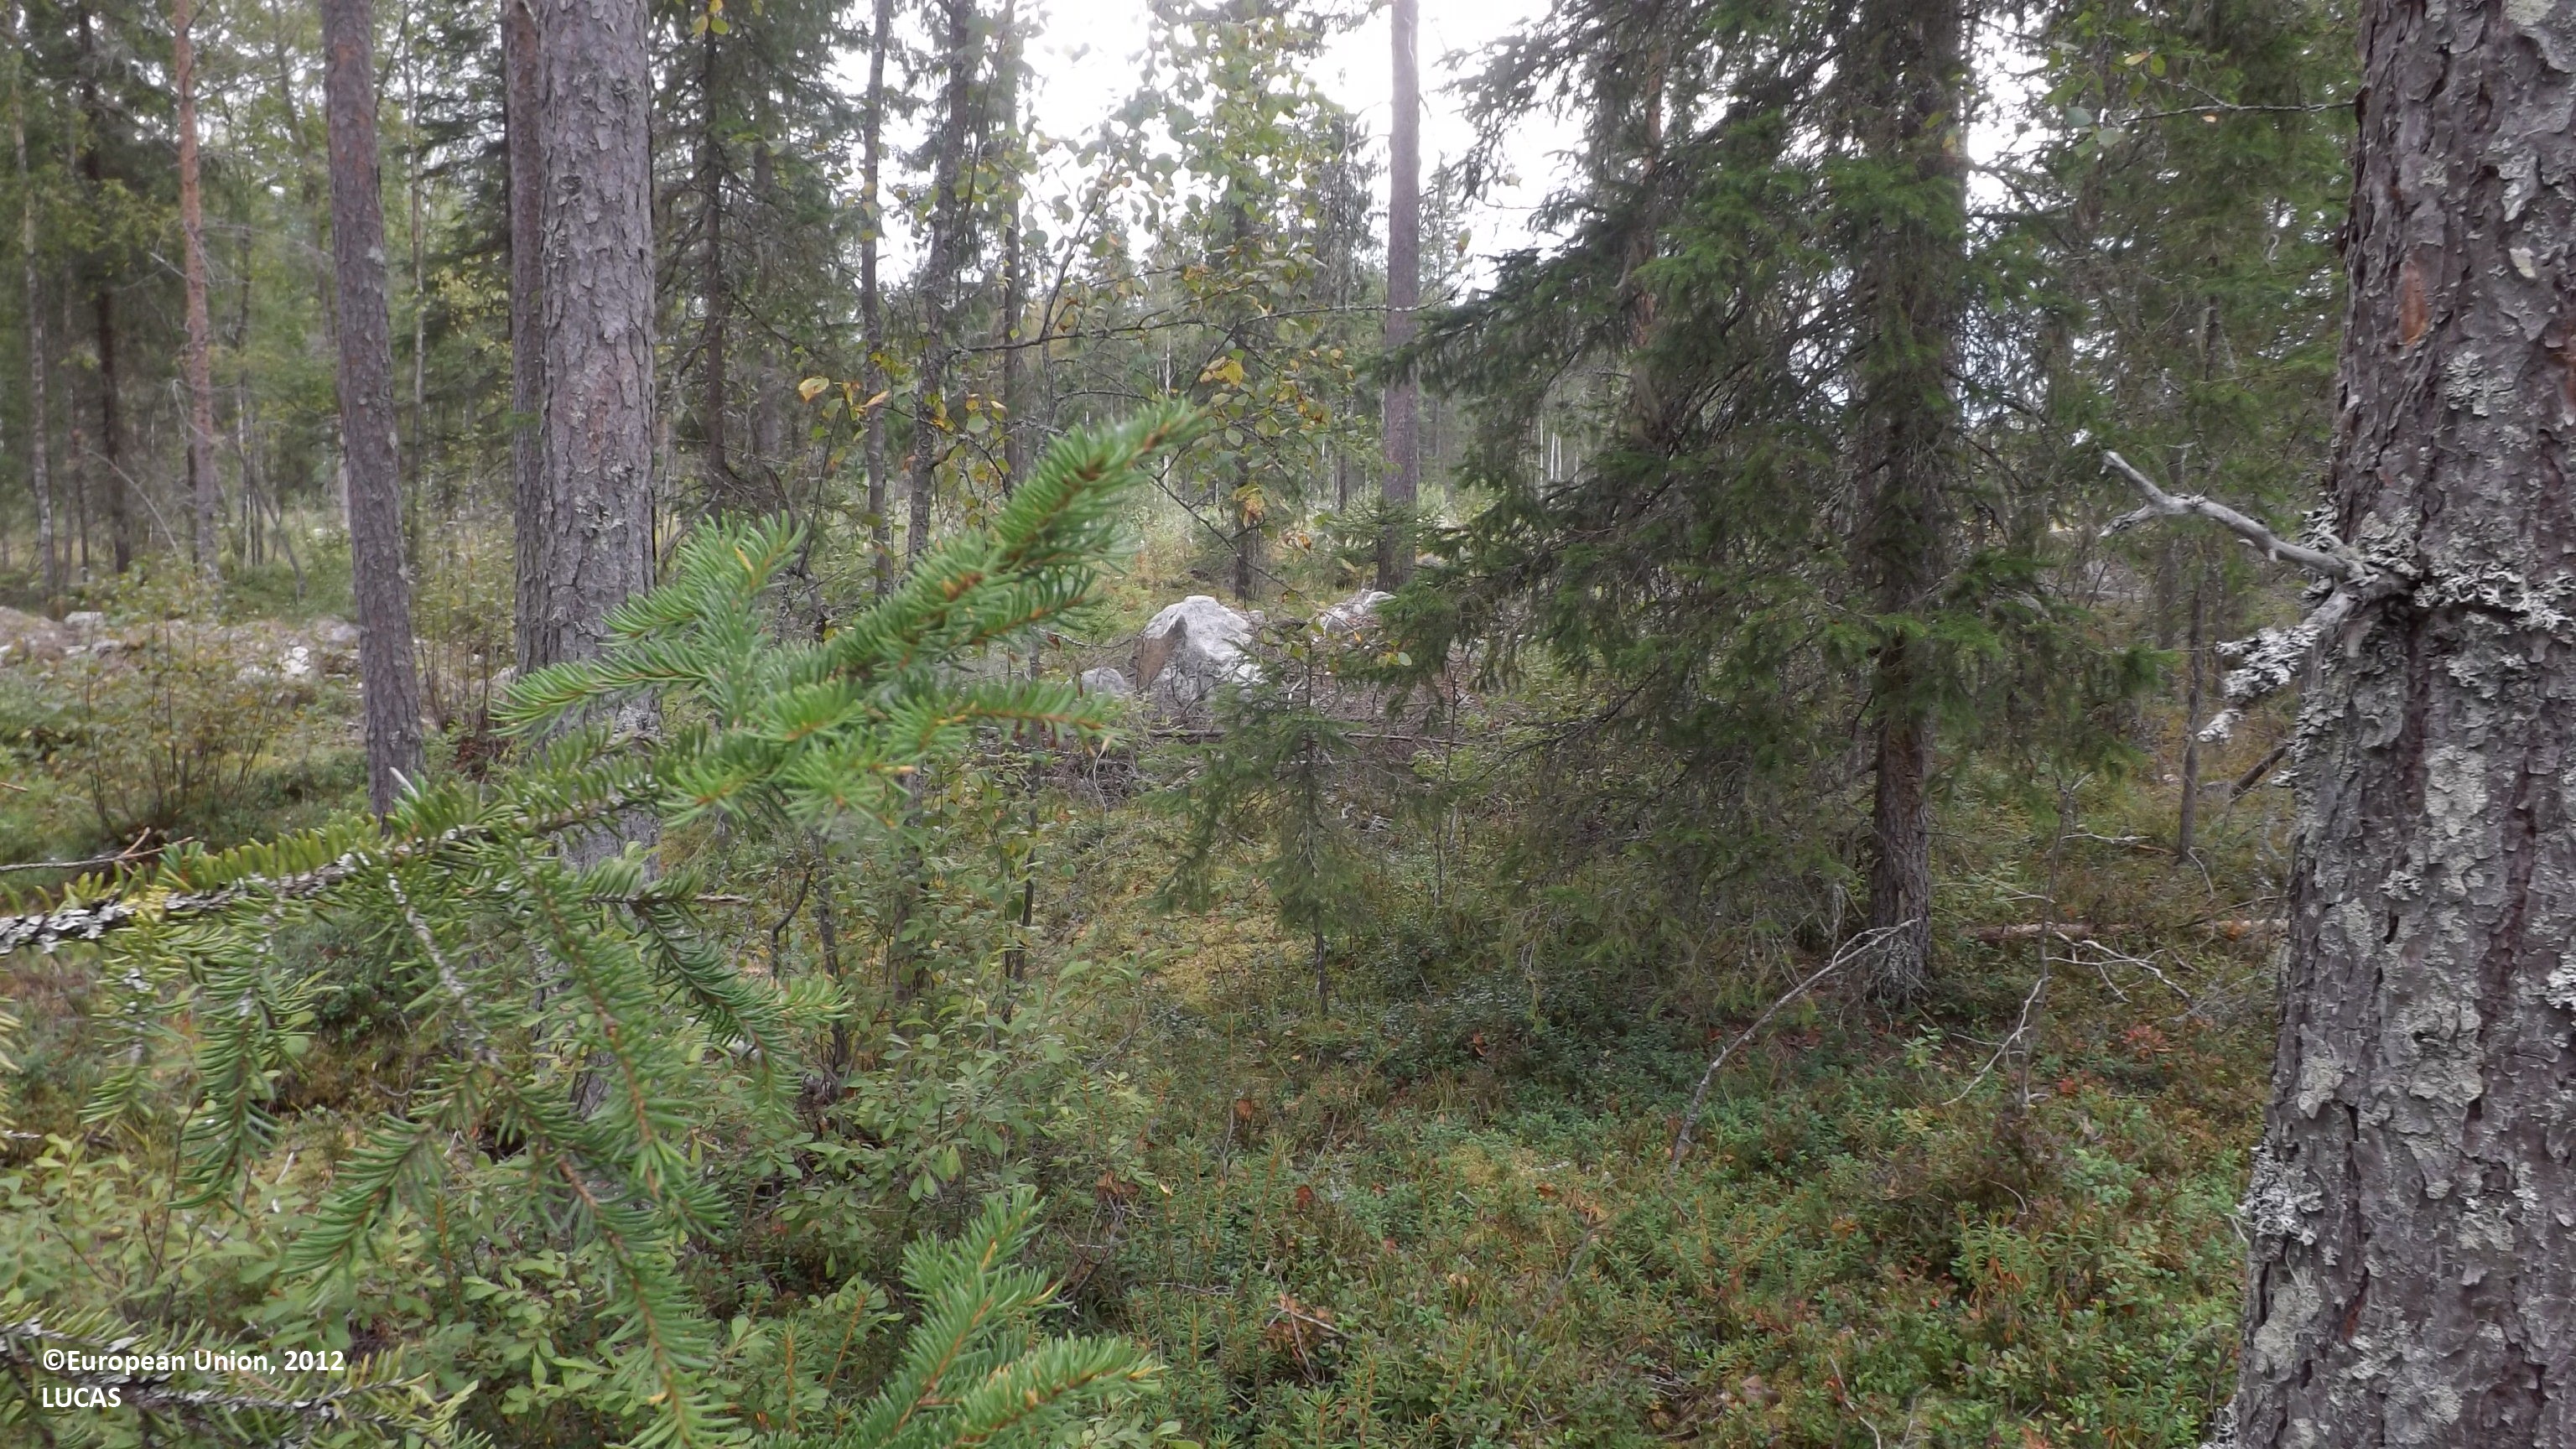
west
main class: Woodland
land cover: Other mixed woodland
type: boreal forest
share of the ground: 25 - 50 %
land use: Forestry
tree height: > 5 m
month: August
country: FI
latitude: 63.9639
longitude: 23.9294
